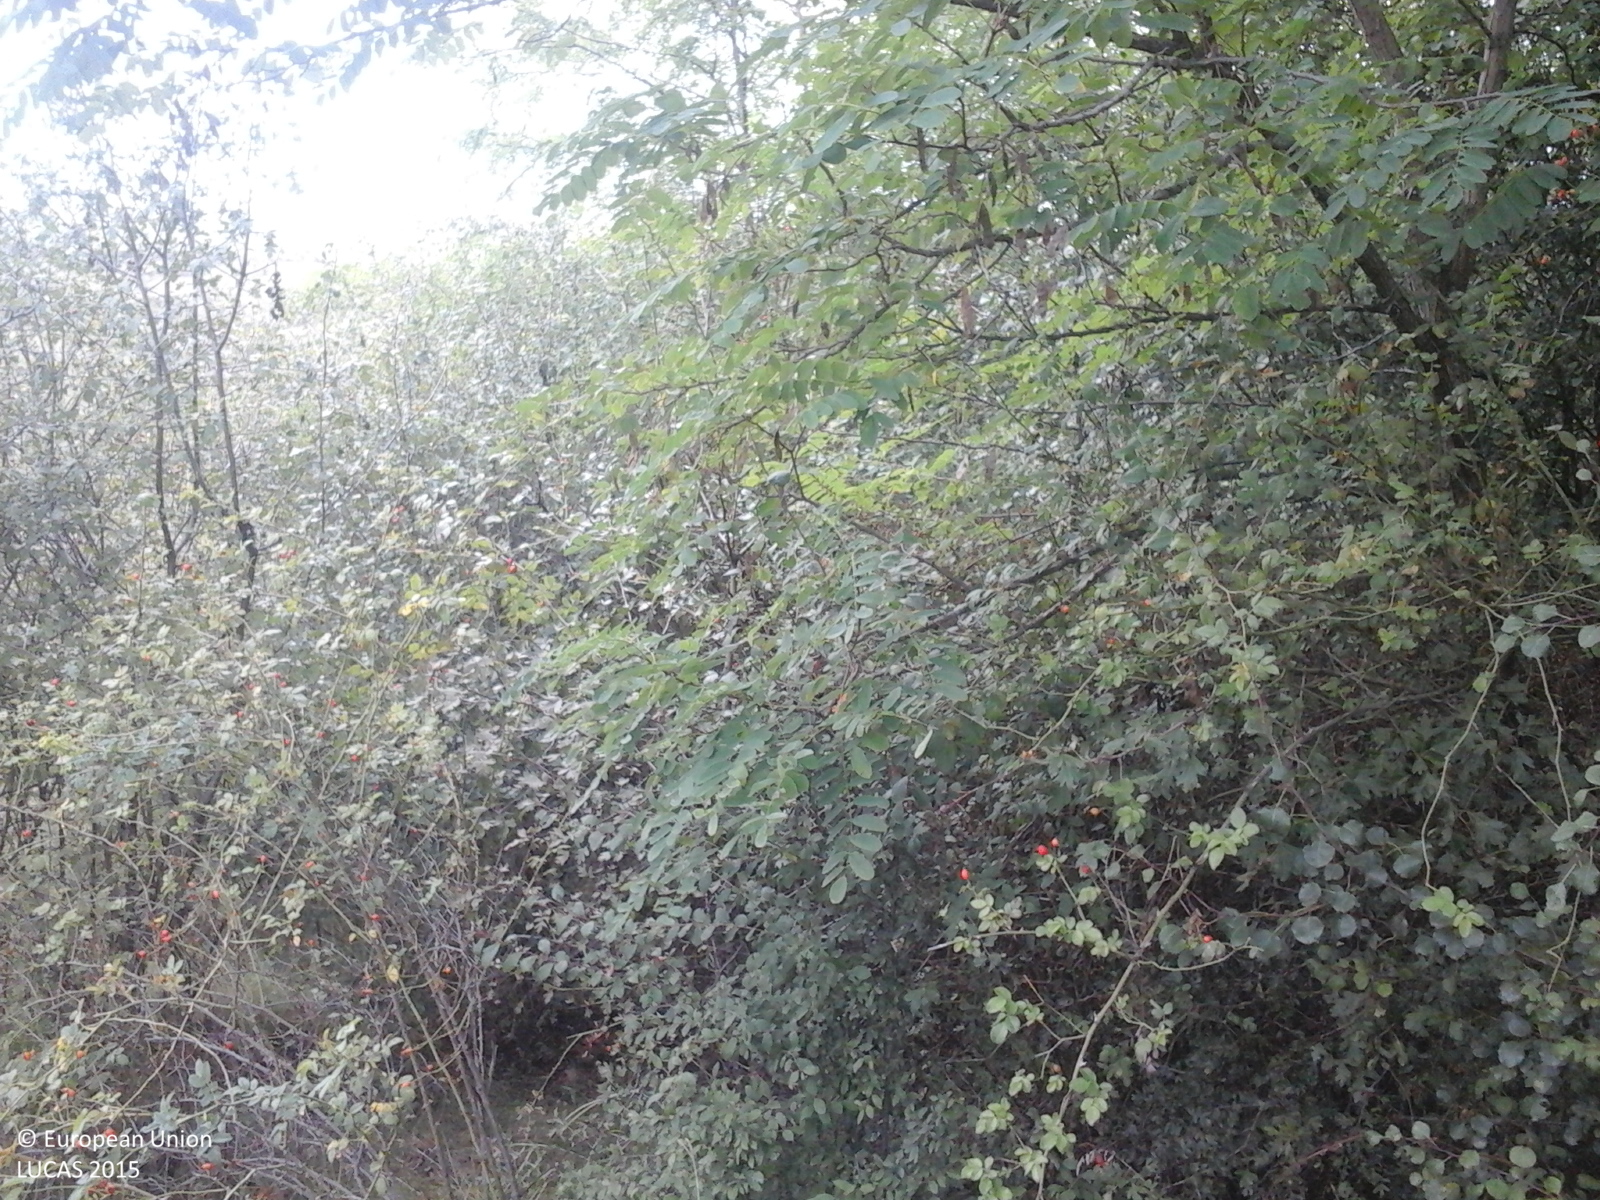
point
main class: Woodland
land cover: Broadleaved woodland
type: exotic forest
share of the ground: > 75 %
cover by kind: broadleaved forest trees 100 %
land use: Forestry
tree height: > 5 m
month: September
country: RO
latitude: 47.4492
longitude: 22.6990
